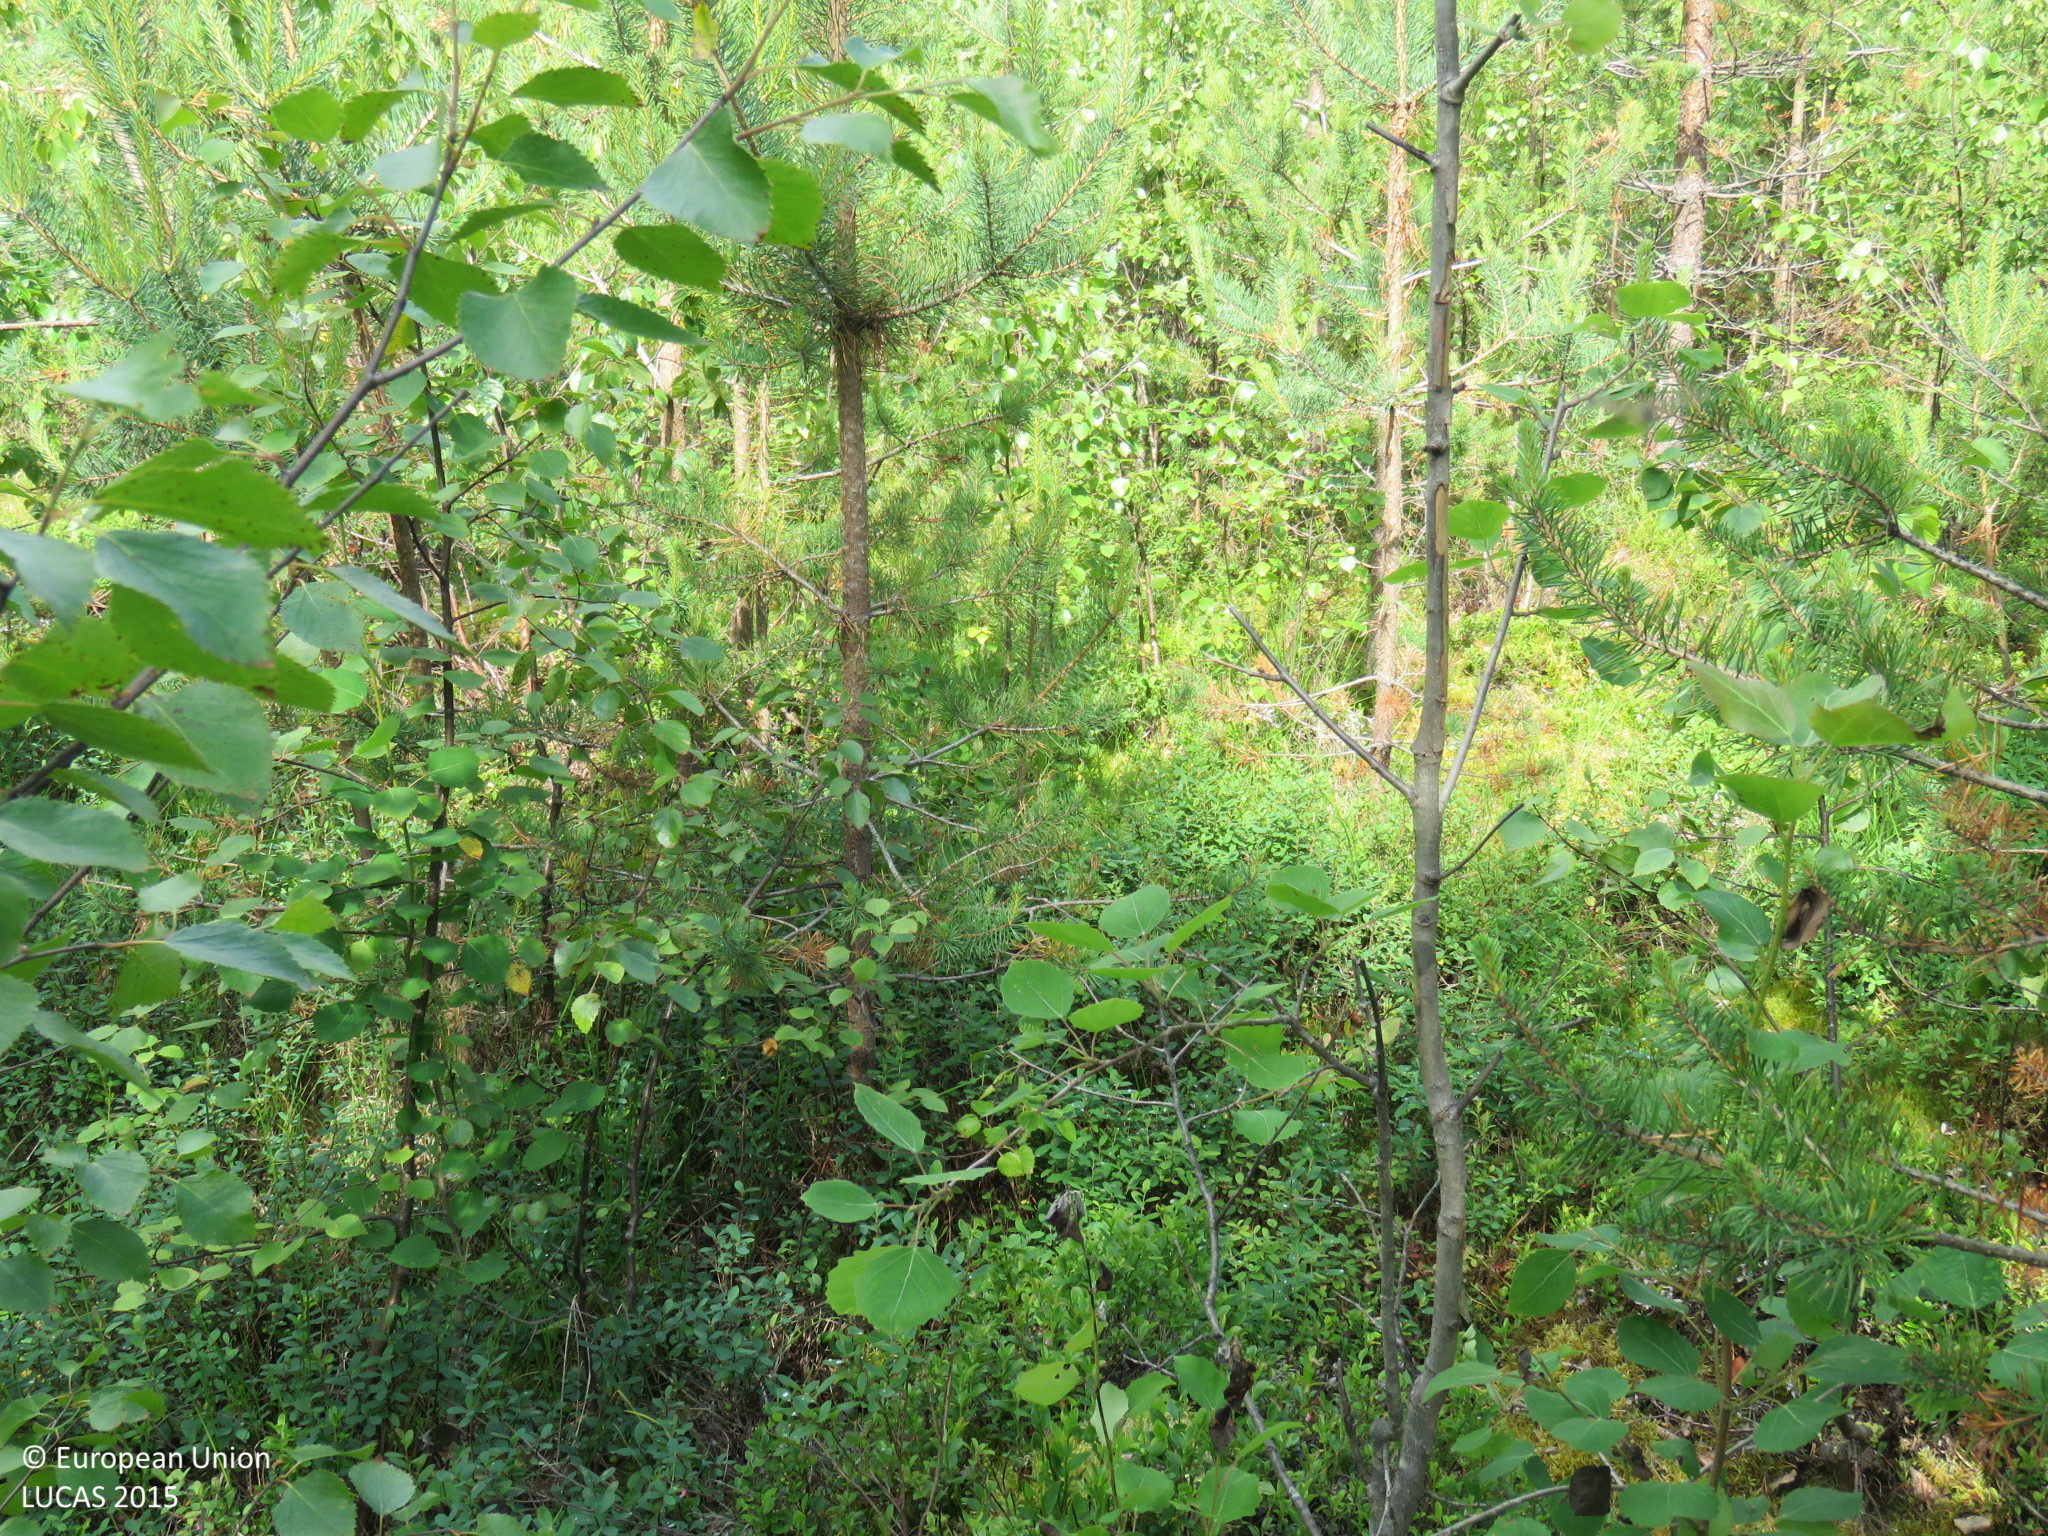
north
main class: Woodland
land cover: Pine dominated mixed woodland
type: boreal forest
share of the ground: > 75 %
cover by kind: broadleaved forest trees 50 %, coniferous forest trees 45 %, shrubs 5 %
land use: Forestry
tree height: < 5 m
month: July
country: FI
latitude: 64.6384
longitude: 26.4964
